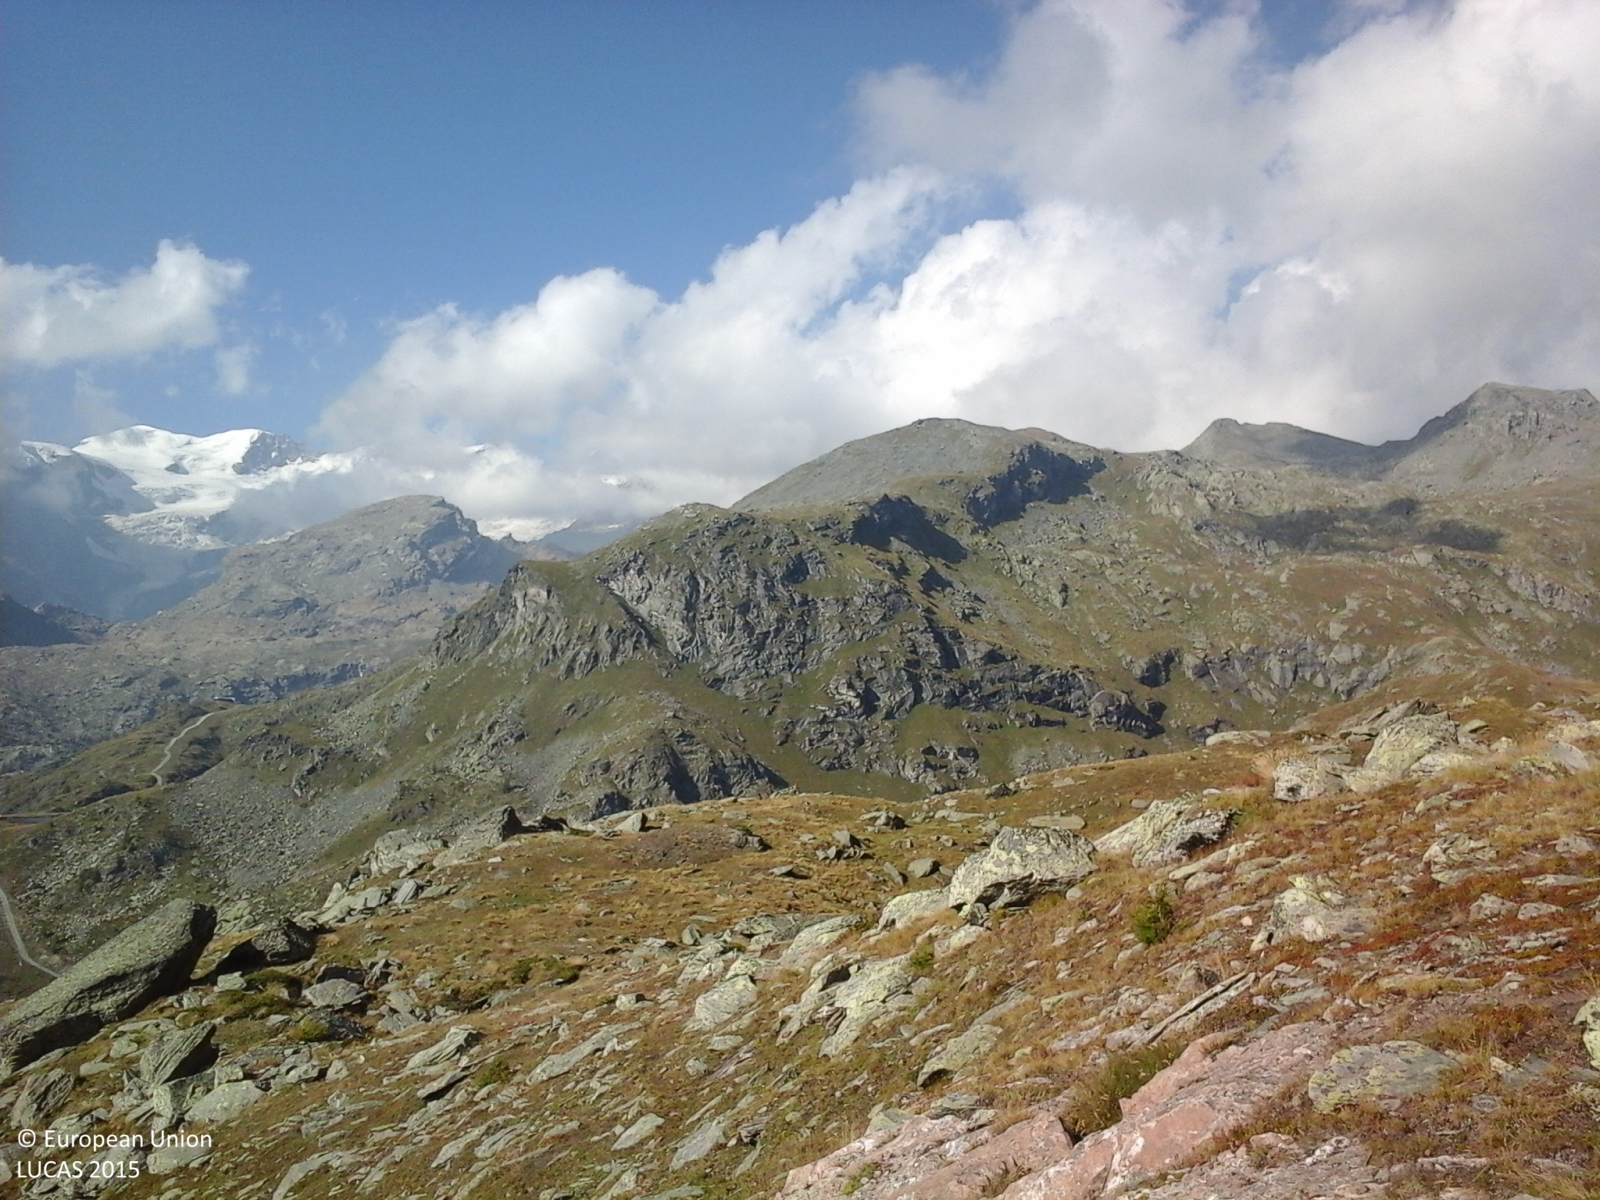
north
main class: Grassland
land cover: Grassland without tree/shrub cover
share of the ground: > 75 %
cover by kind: herbaceous plants 100 %
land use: Agriculture (excluding fallow land and kitchen gardens)
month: August
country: IT
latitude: 45.8410
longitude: 7.7499
